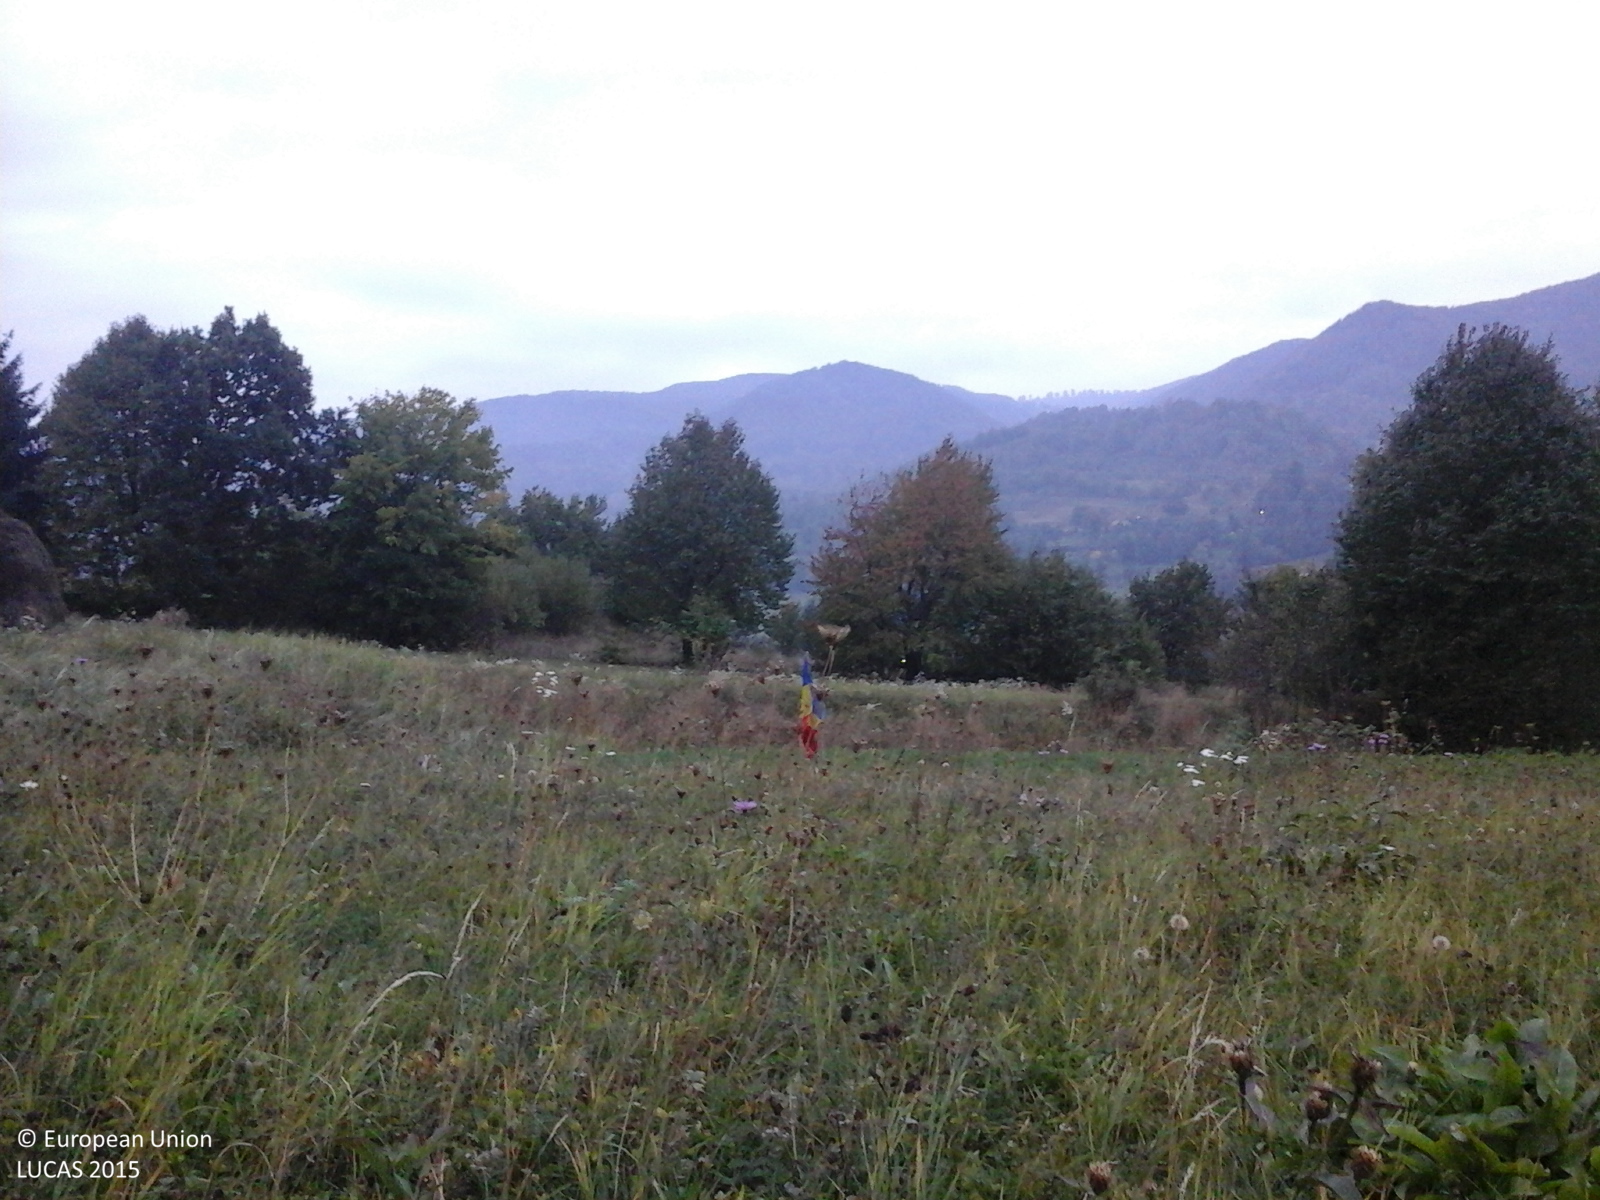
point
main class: Grassland
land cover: Grassland without tree/shrub cover
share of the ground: > 75 %
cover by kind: herbaceous plants 100 %
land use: Agriculture (excluding fallow land and kitchen gardens)
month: October
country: RO
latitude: 46.7667
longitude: 25.0141
